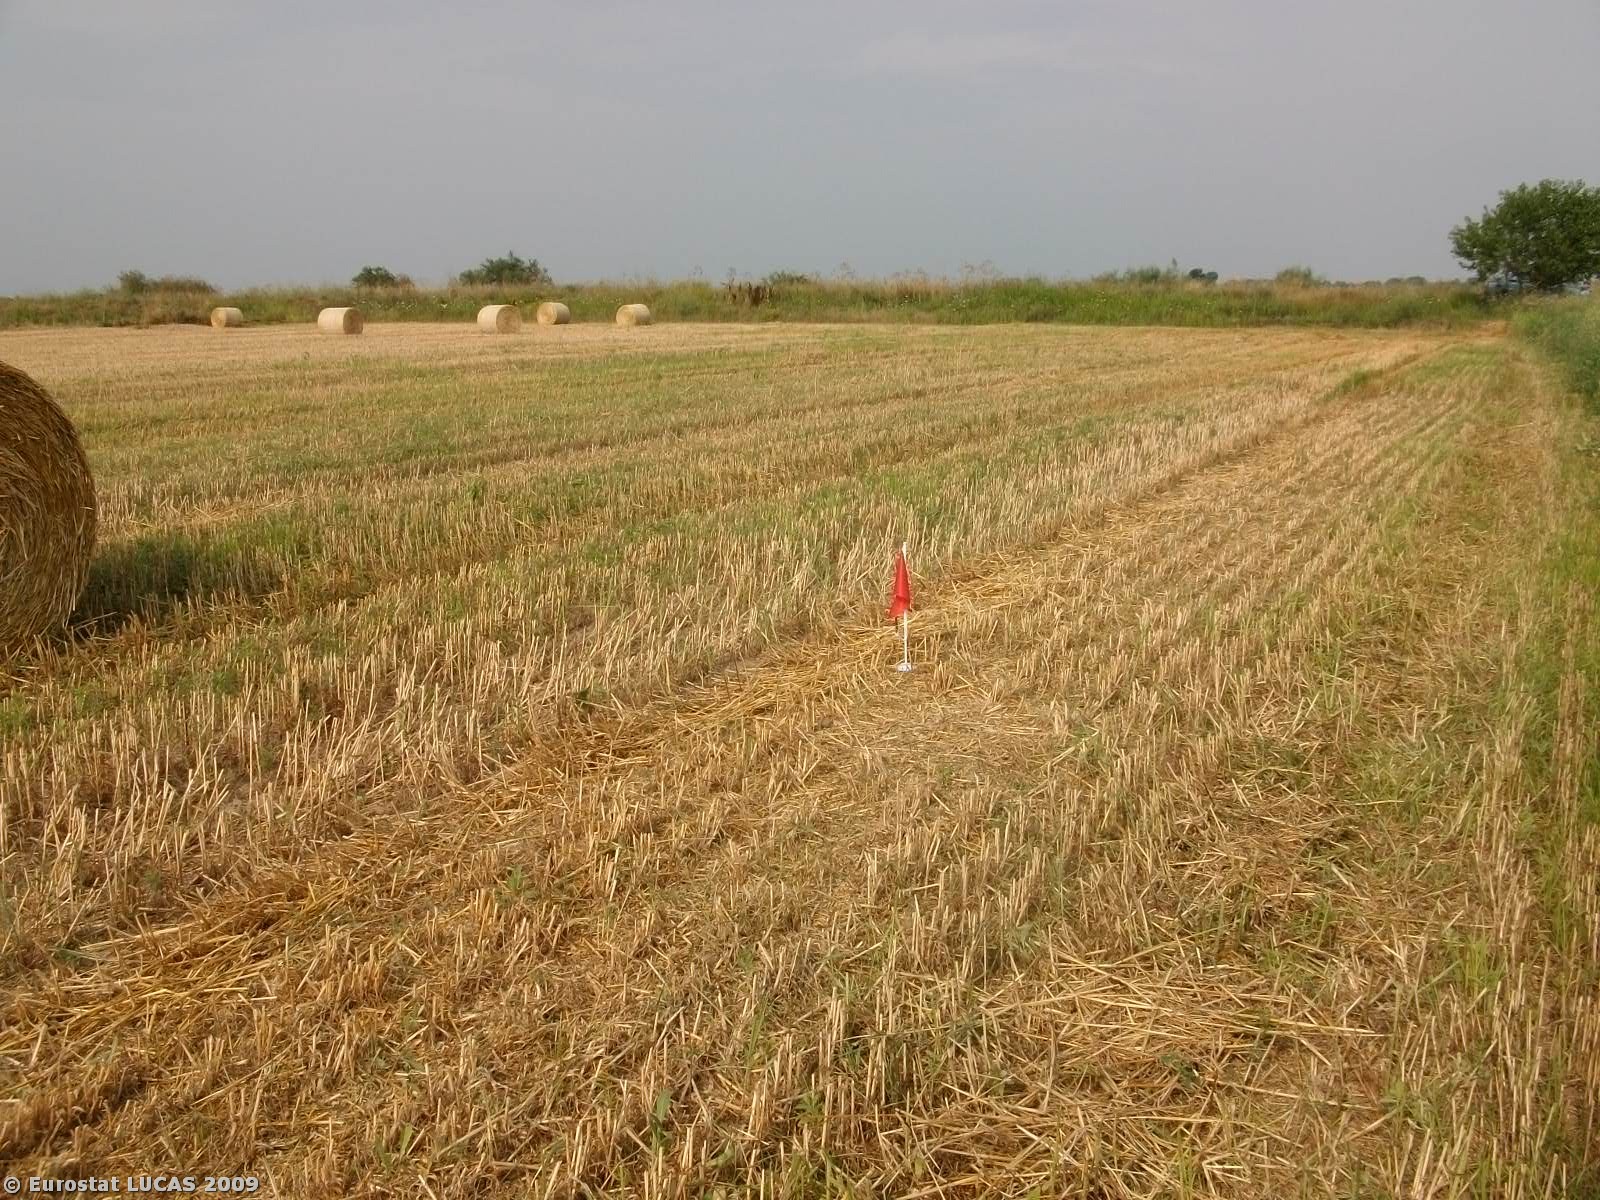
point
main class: Cropland
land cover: Durum wheat
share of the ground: < 10 %
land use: Agriculture (excluding fallow land and kitchen gardens)
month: July
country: GR
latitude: 40.8639
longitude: 26.1860
